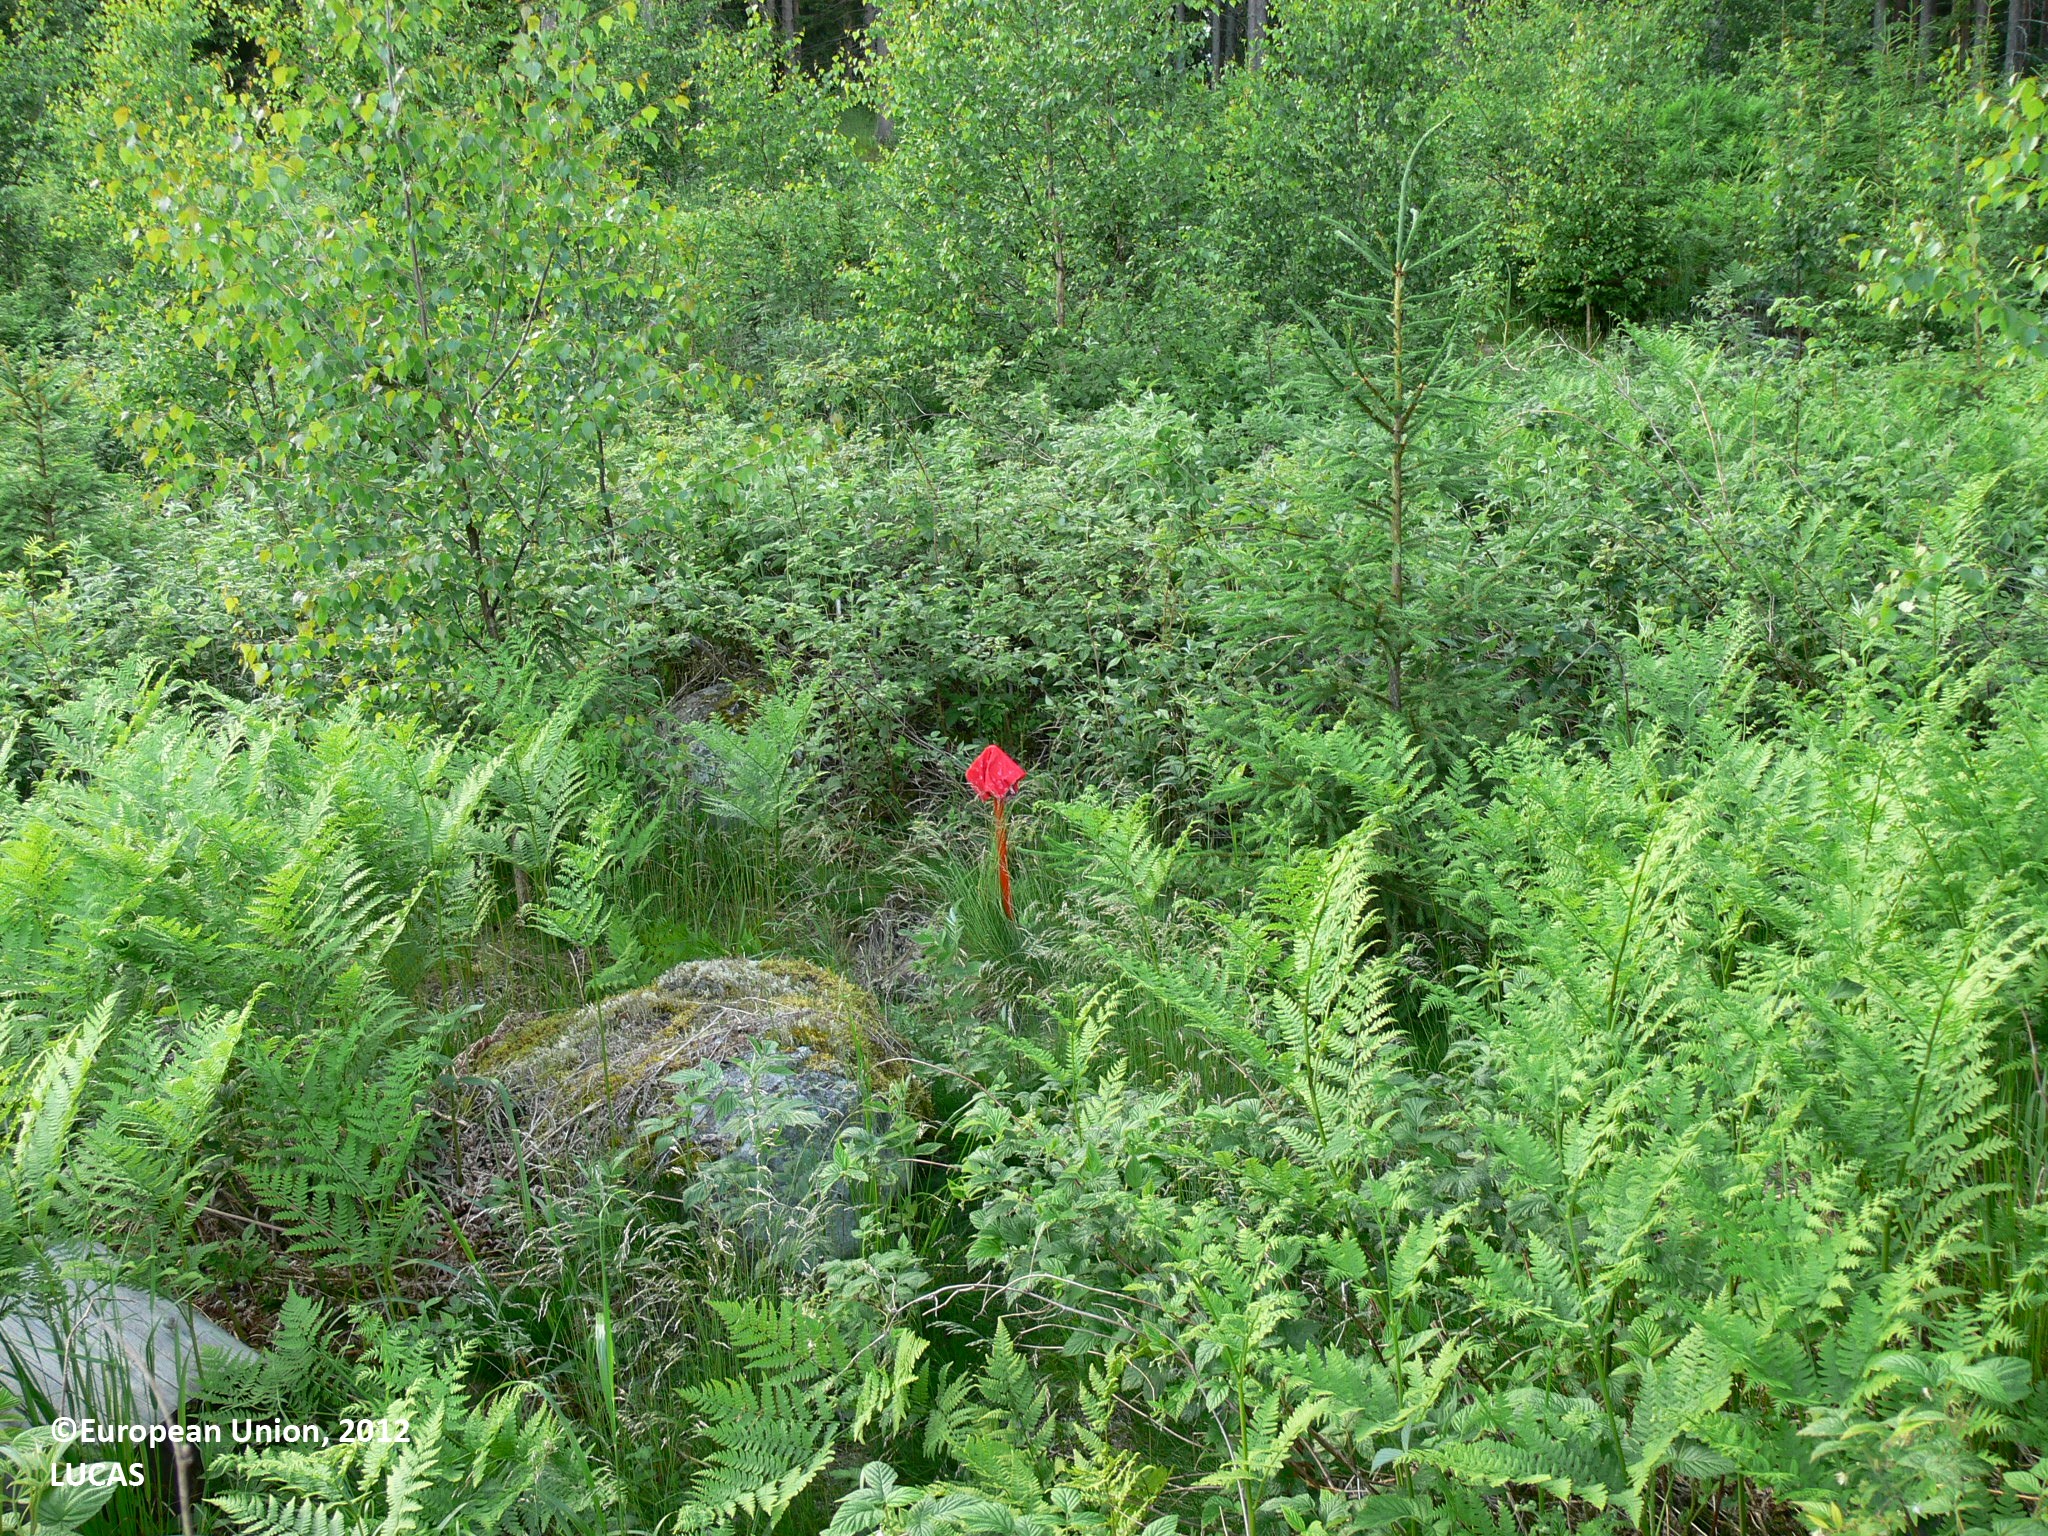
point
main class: Woodland
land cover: Spruce dominated mixed woodland
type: boreal forest
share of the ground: 25 - 50 %
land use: Forestry
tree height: < 5 m
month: June
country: FI
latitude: 62.3617
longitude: 29.5066
